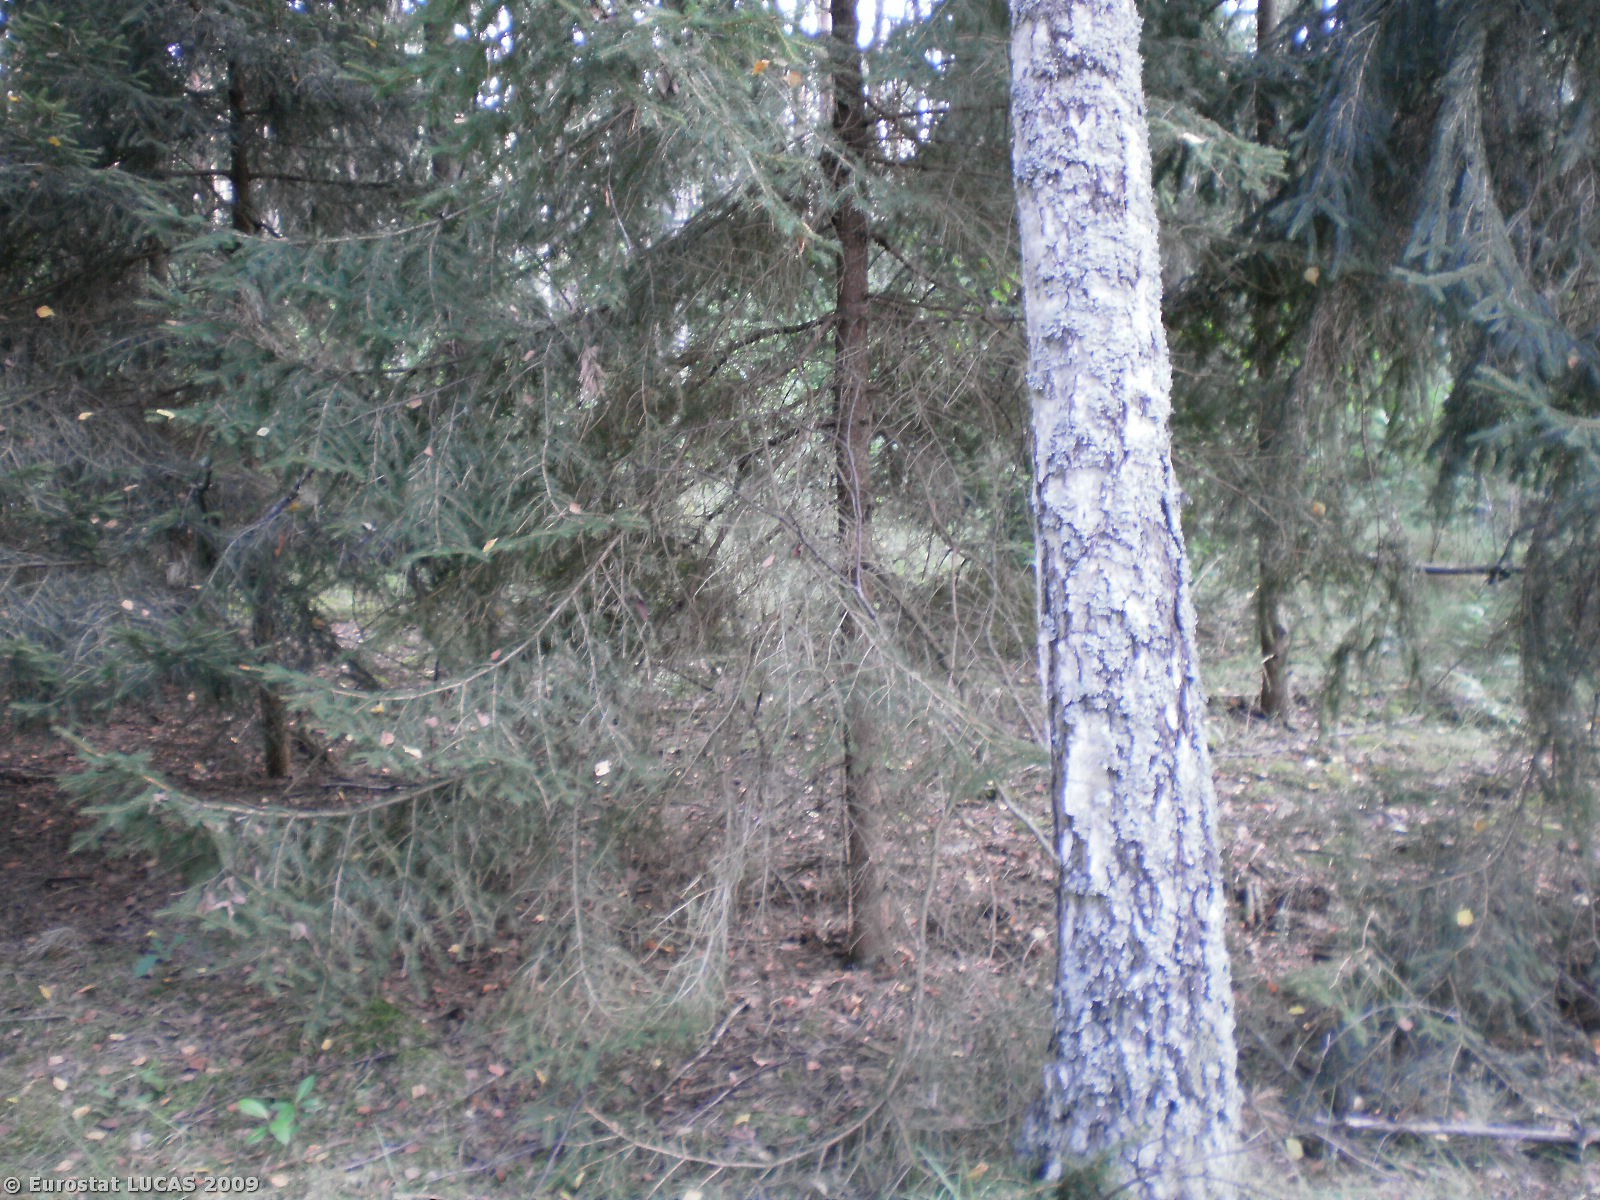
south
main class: Woodland
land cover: Mixed woodland
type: hemiboreal forest and nemoral coniferous forest and mixed broadleaved-coniferous forest
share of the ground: > 75 %
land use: Forestry
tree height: > 5 m
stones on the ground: < 10 %
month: July
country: PL
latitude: 53.3533
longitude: 20.9957
